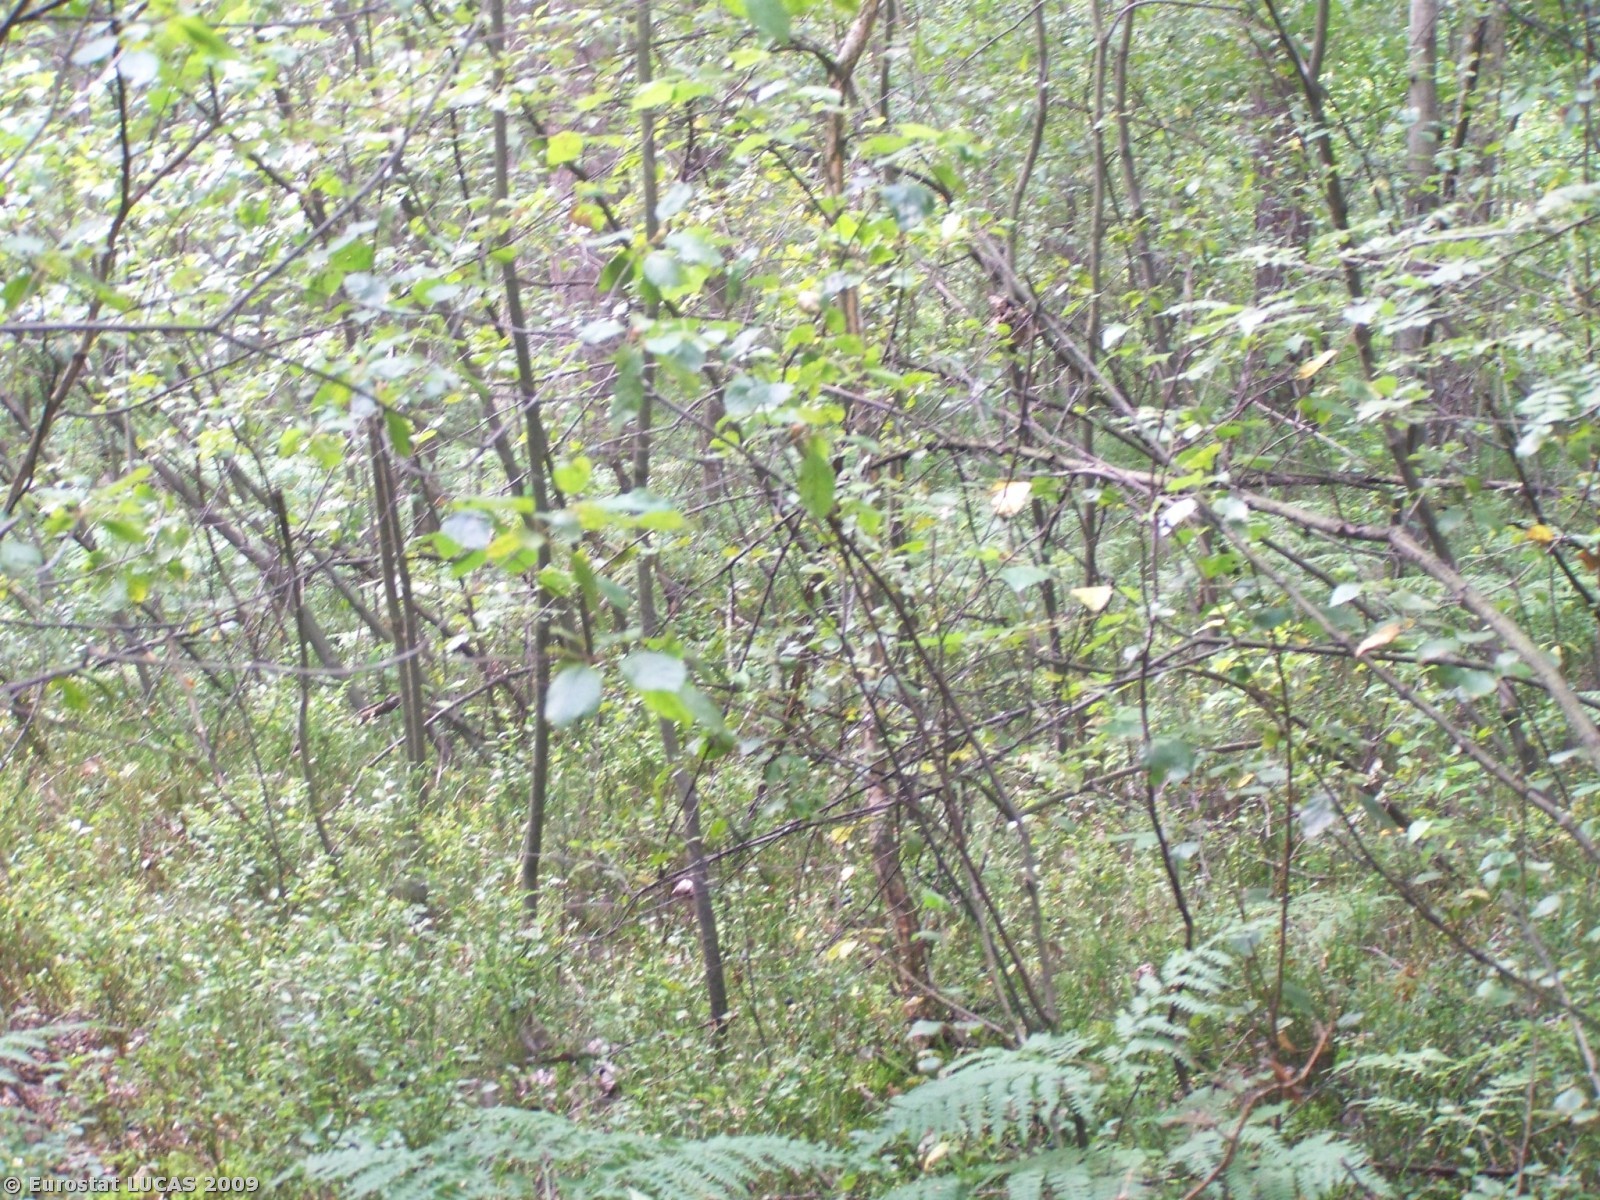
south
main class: Woodland
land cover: Mixed woodland
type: hemiboreal forest and nemoral coniferous forest and mixed broadleaved-coniferous forest
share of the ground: > 75 %
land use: Forestry
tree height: > 5 m
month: July
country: PL
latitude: 52.1299
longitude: 21.6374
